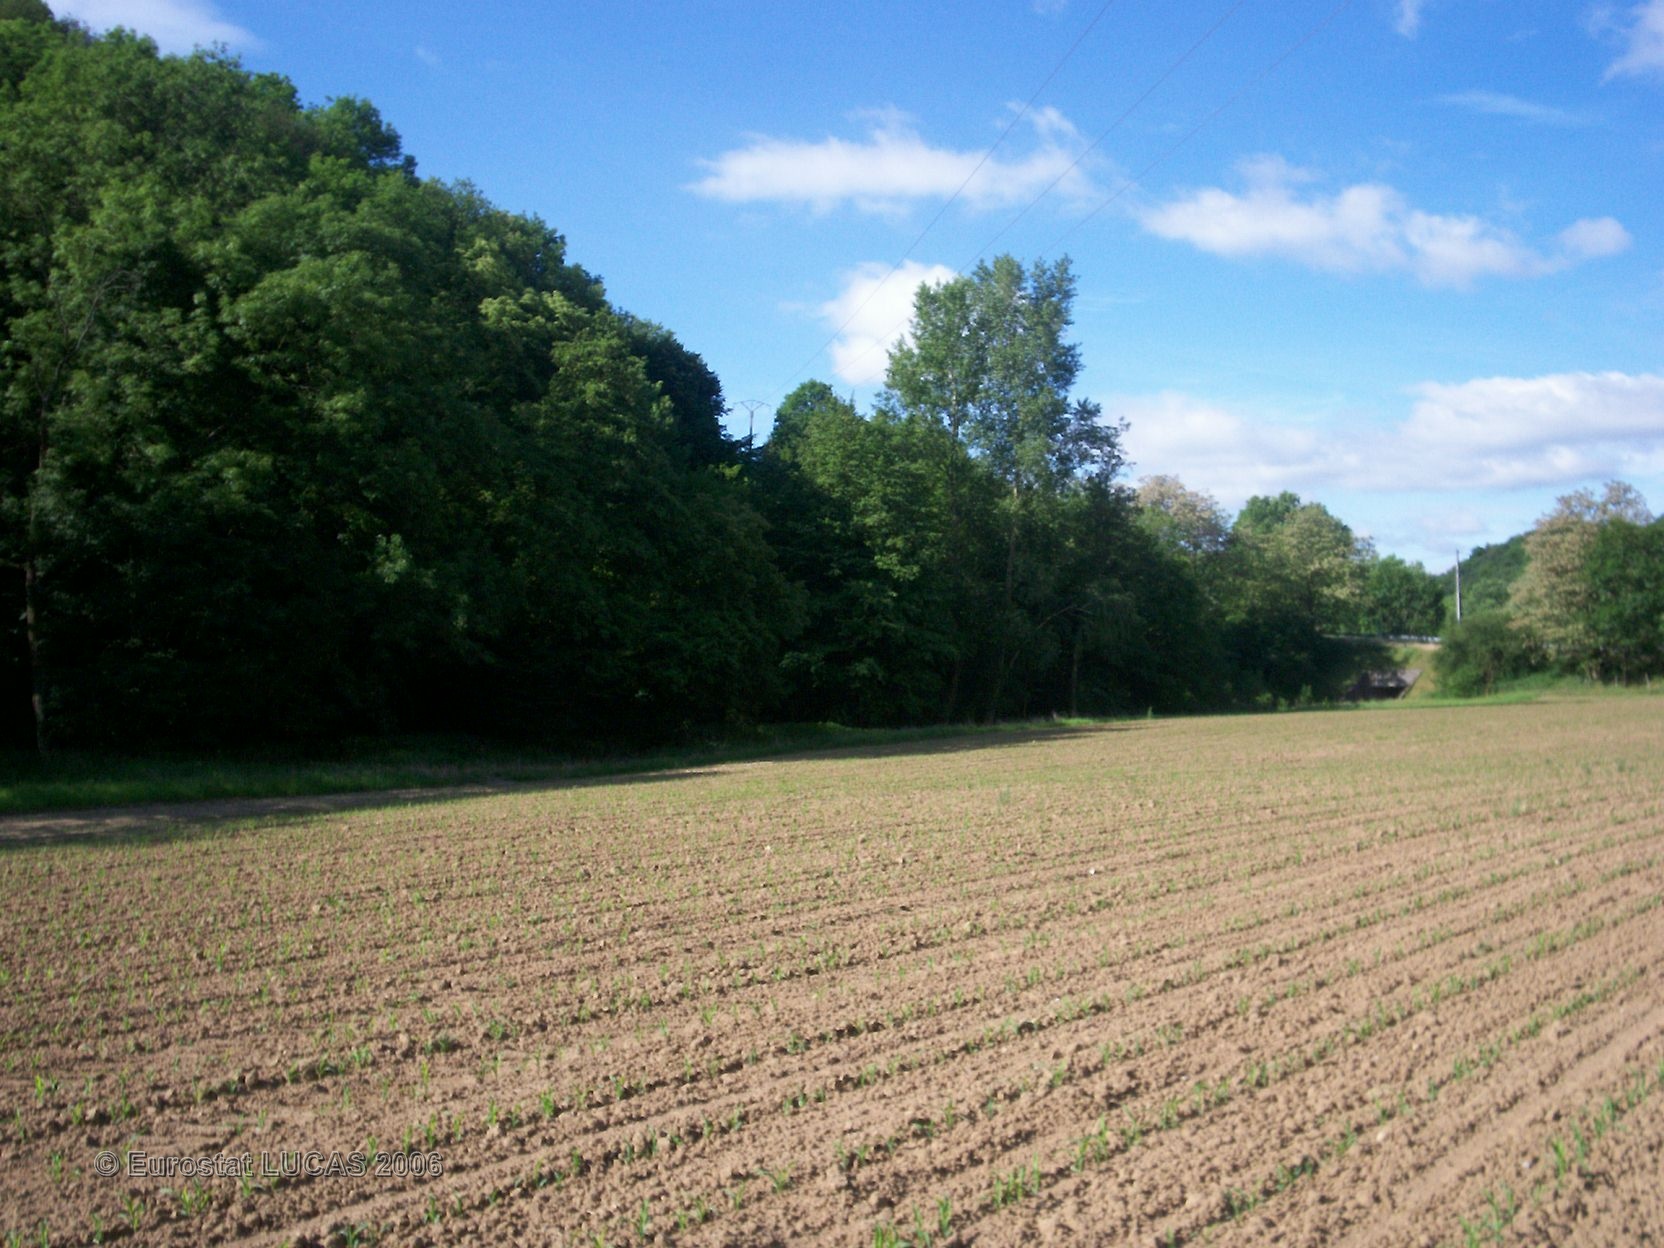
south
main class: Cropland
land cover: Maize
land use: Agriculture (excluding fallow land and kitchen gardens)
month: May
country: FR
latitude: 45.6090
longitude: 4.7595
